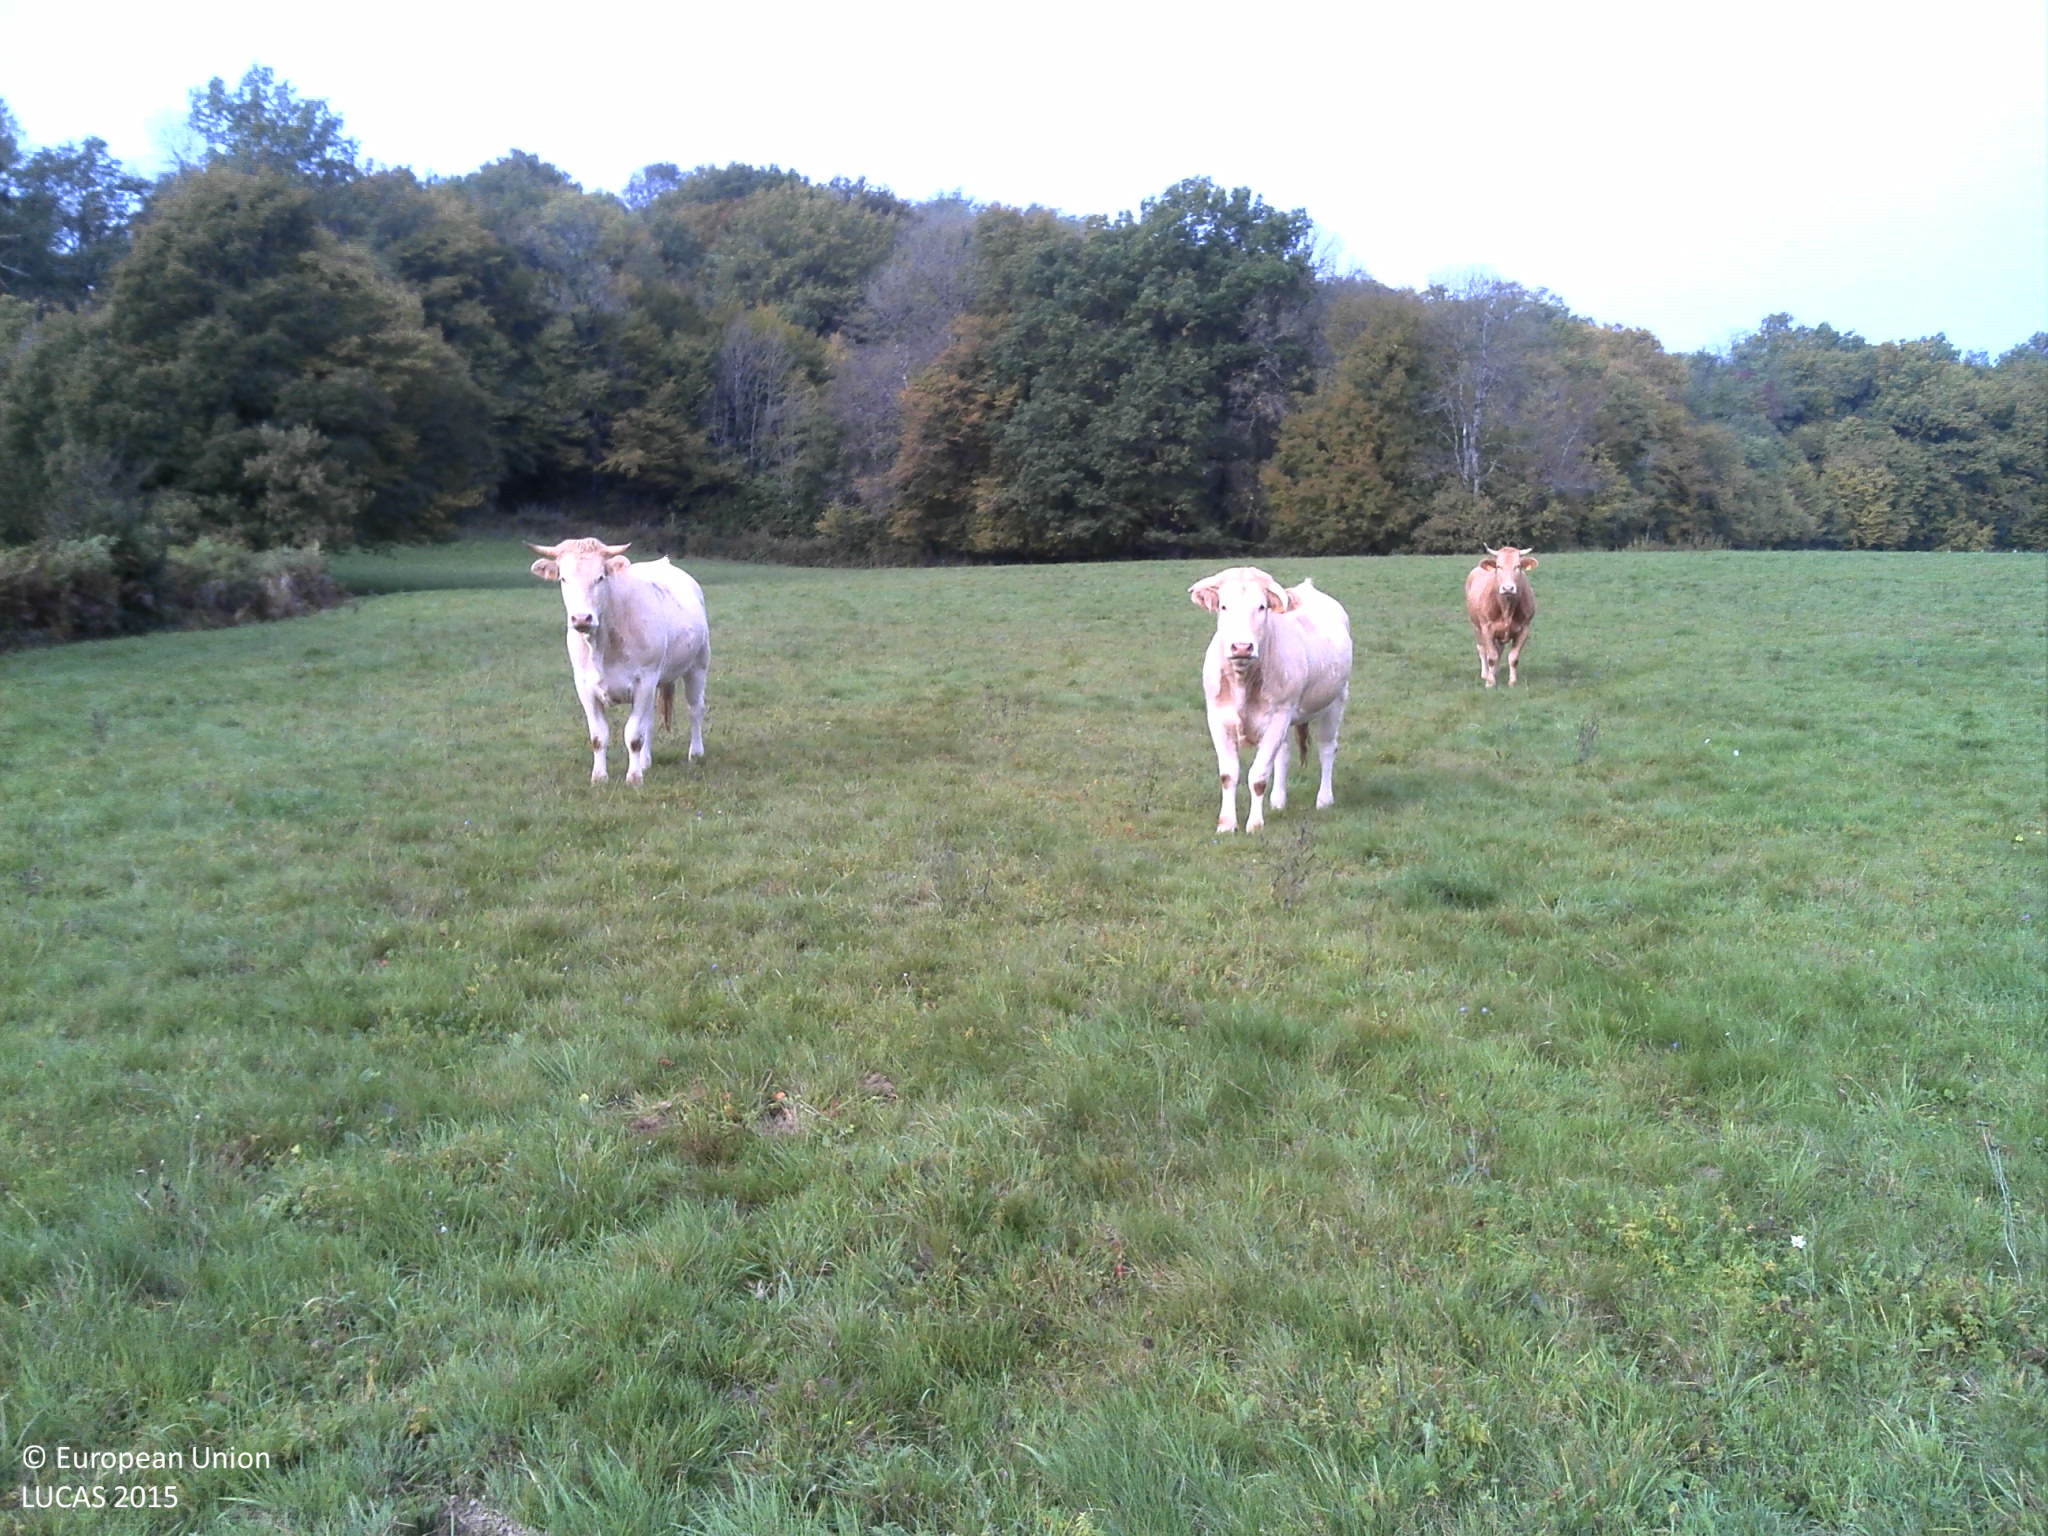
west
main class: Grassland
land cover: Grassland without tree/shrub cover
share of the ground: > 75 %
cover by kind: herbaceous plants 100 %
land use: Agriculture (excluding fallow land and kitchen gardens)
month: October
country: FR
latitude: 46.1073
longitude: 5.3846
